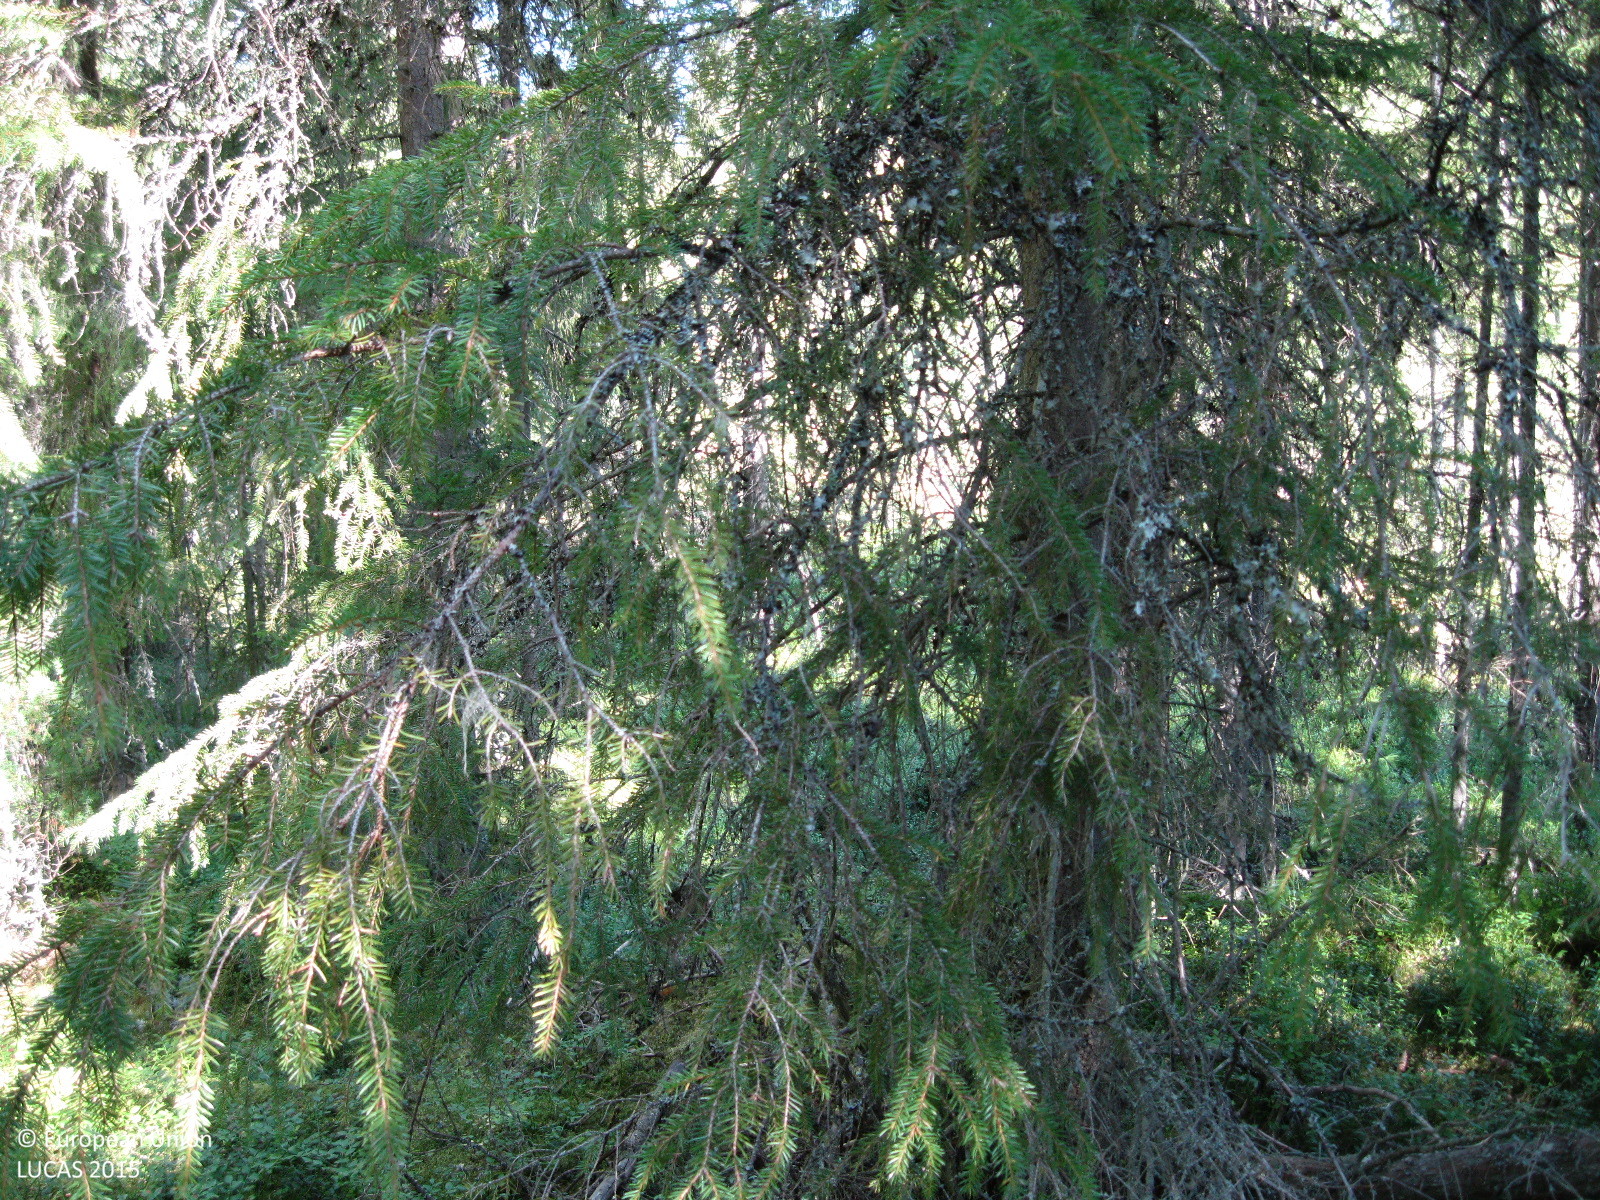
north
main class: Woodland
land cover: Other coniferous woodland
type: boreal forest
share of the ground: 50 - 75 %
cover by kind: coniferous forest trees 50 %, lichens and mosses 25 %, shrubs 15 %, broadleaved forest trees 10 %
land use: Forestry
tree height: > 5 m
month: August
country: FI
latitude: 61.4535
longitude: 25.1387
